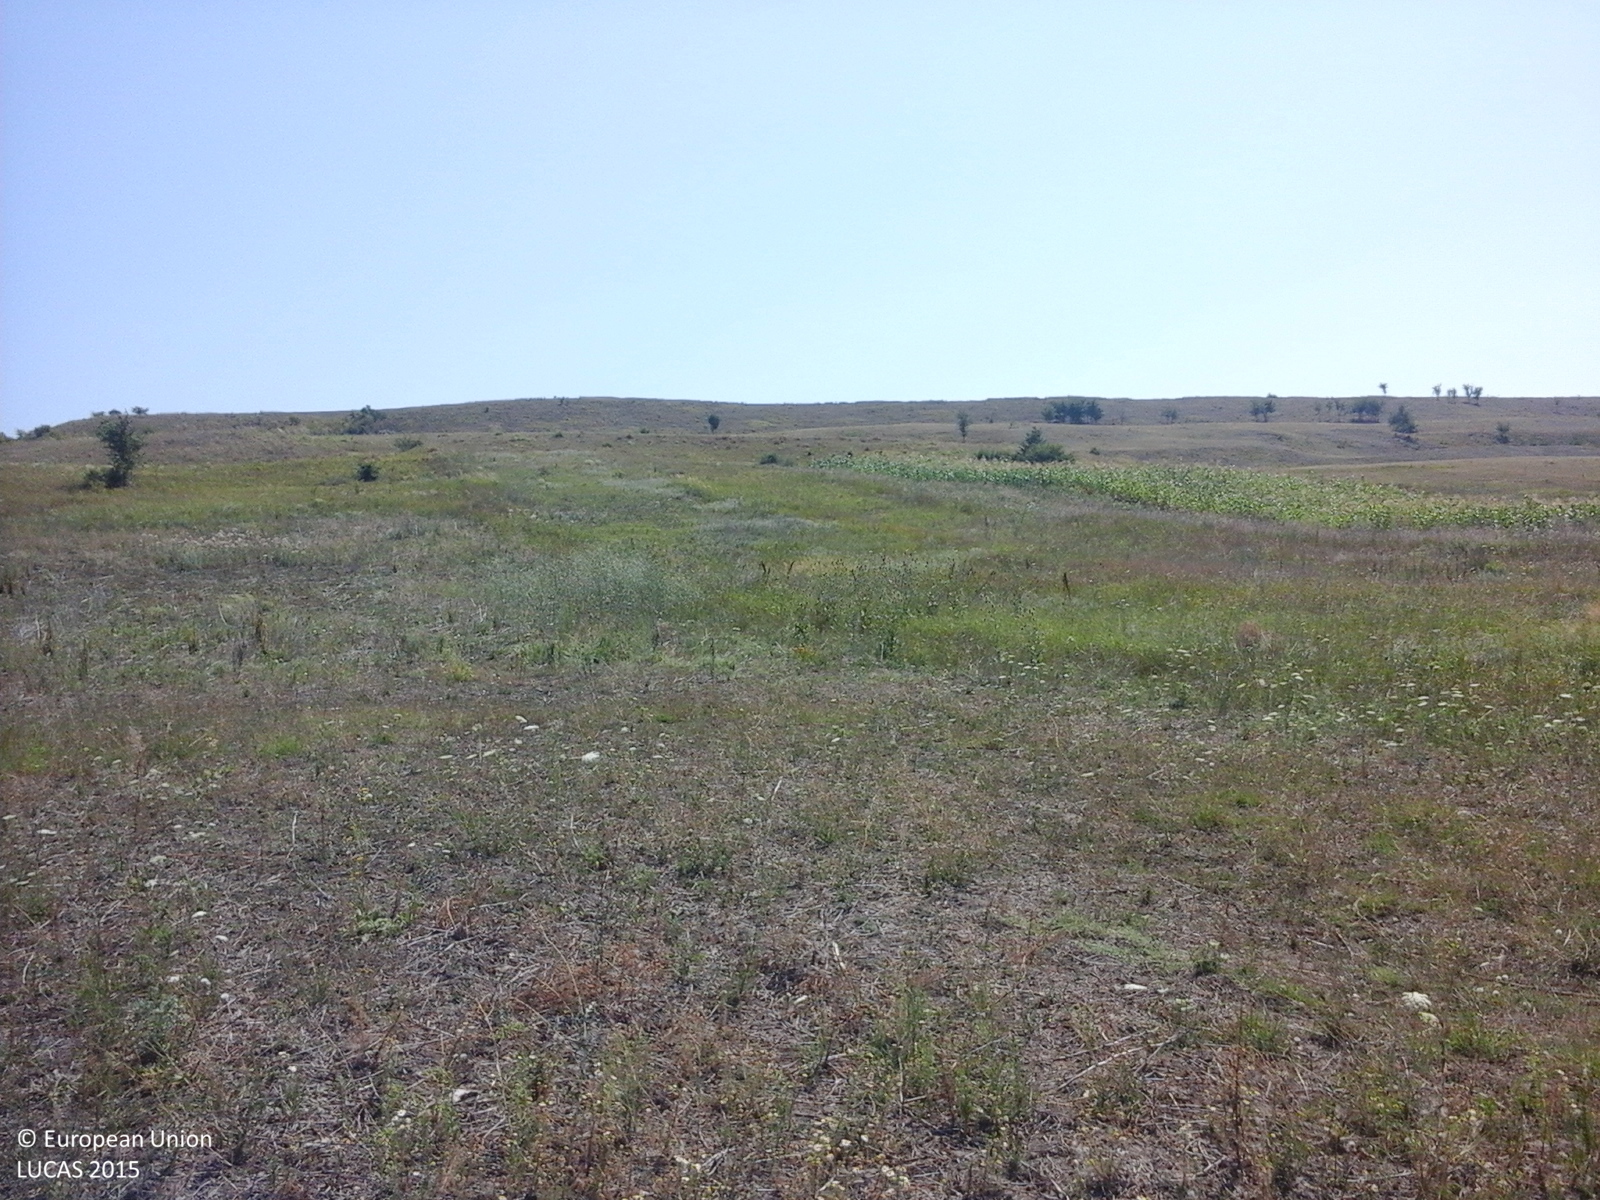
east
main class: Grassland
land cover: Spontaneously vegetated surfaces
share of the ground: 25 - 50 %
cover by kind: herbaceous plants 100 %
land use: Fallow land
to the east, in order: Spontaneously vegetated surfaces; Grassland without tree/shrub cover; Maize; Grassland without tree/shrub cover; Tracks; Grassland without tree/shrub cover
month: July
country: RO
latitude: 46.2278
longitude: 27.2282
